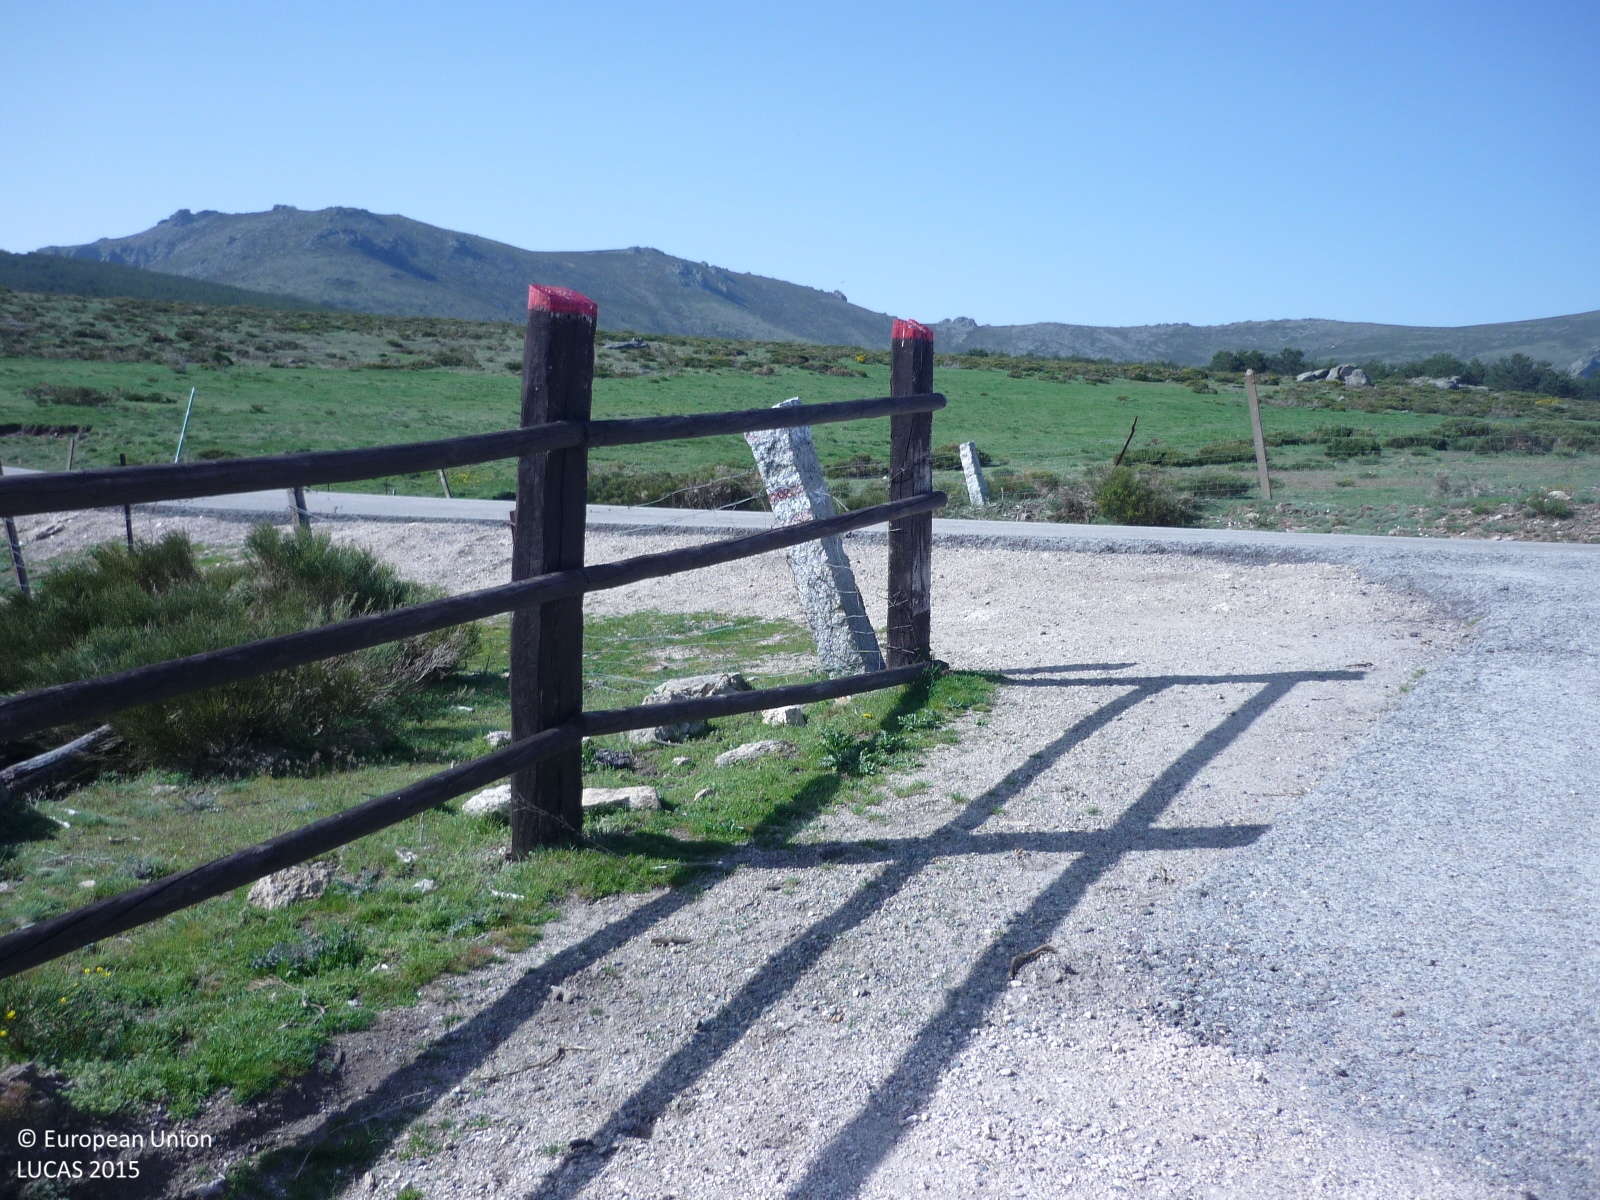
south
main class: Shrubland
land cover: Shrubland with sparse tree cover
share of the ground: 25 - 50 %
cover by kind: herbaceous plants 55 %, shrubs 35 %, coniferous forest trees 5 %, unconsolidated bare surface 5 %
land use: Semi-natural and natural areas not in use
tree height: < 5 m
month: May
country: ES
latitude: 40.8598
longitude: -3.8182
